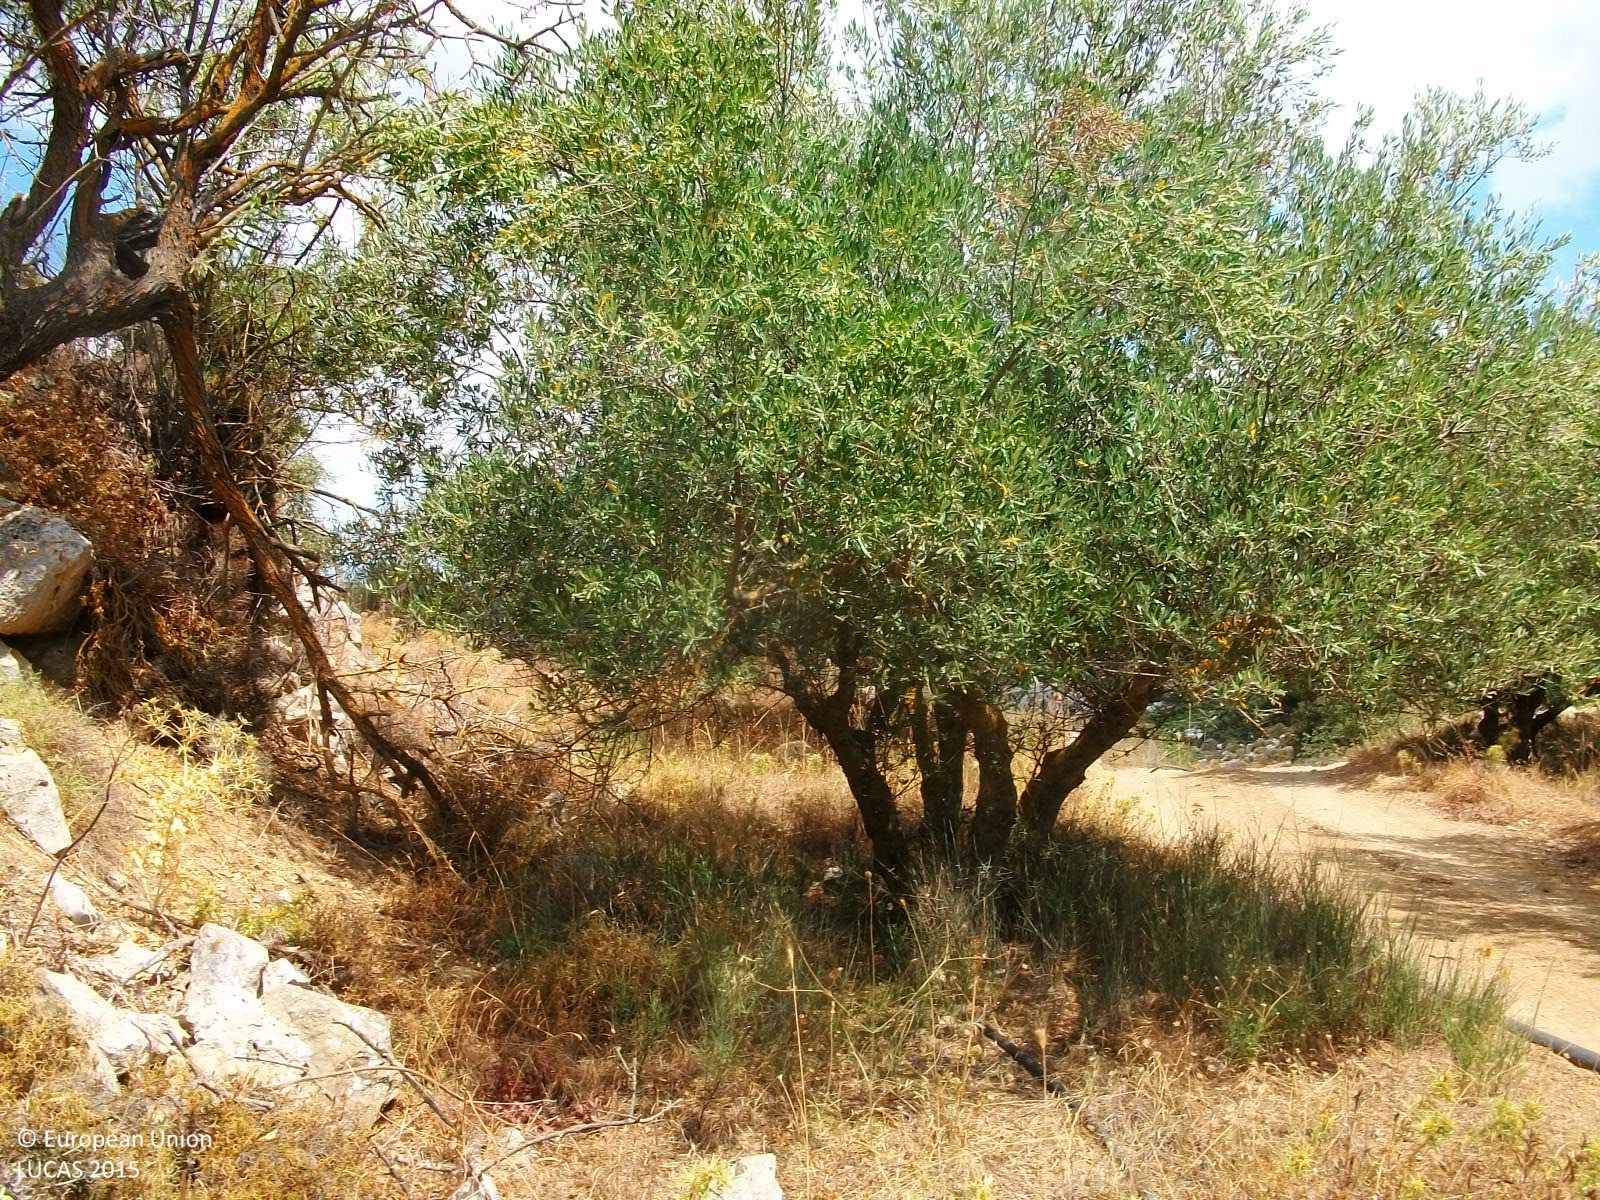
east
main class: Cropland
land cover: Olive groves
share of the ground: 25 - 50 %
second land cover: Spontaneously vegetated surfaces
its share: 50 - 75 %
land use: Agriculture (excluding fallow land and kitchen gardens)
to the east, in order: Olive groves; Spontaneously vegetated surfaces; Fences; Spontaneously vegetated surfaces; Fences; Shrubland without tree cover; Spontaneously vegetated surfaces; Dry stone walls; Spontaneously vegetated surfaces; Tracks; Fences; Spontaneously vegetated surfaces; Rocks and stones; Shrubland without tree cover; Tracks; Shrubland without tree cover
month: August
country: GR
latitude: 35.0541
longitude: 26.1054
